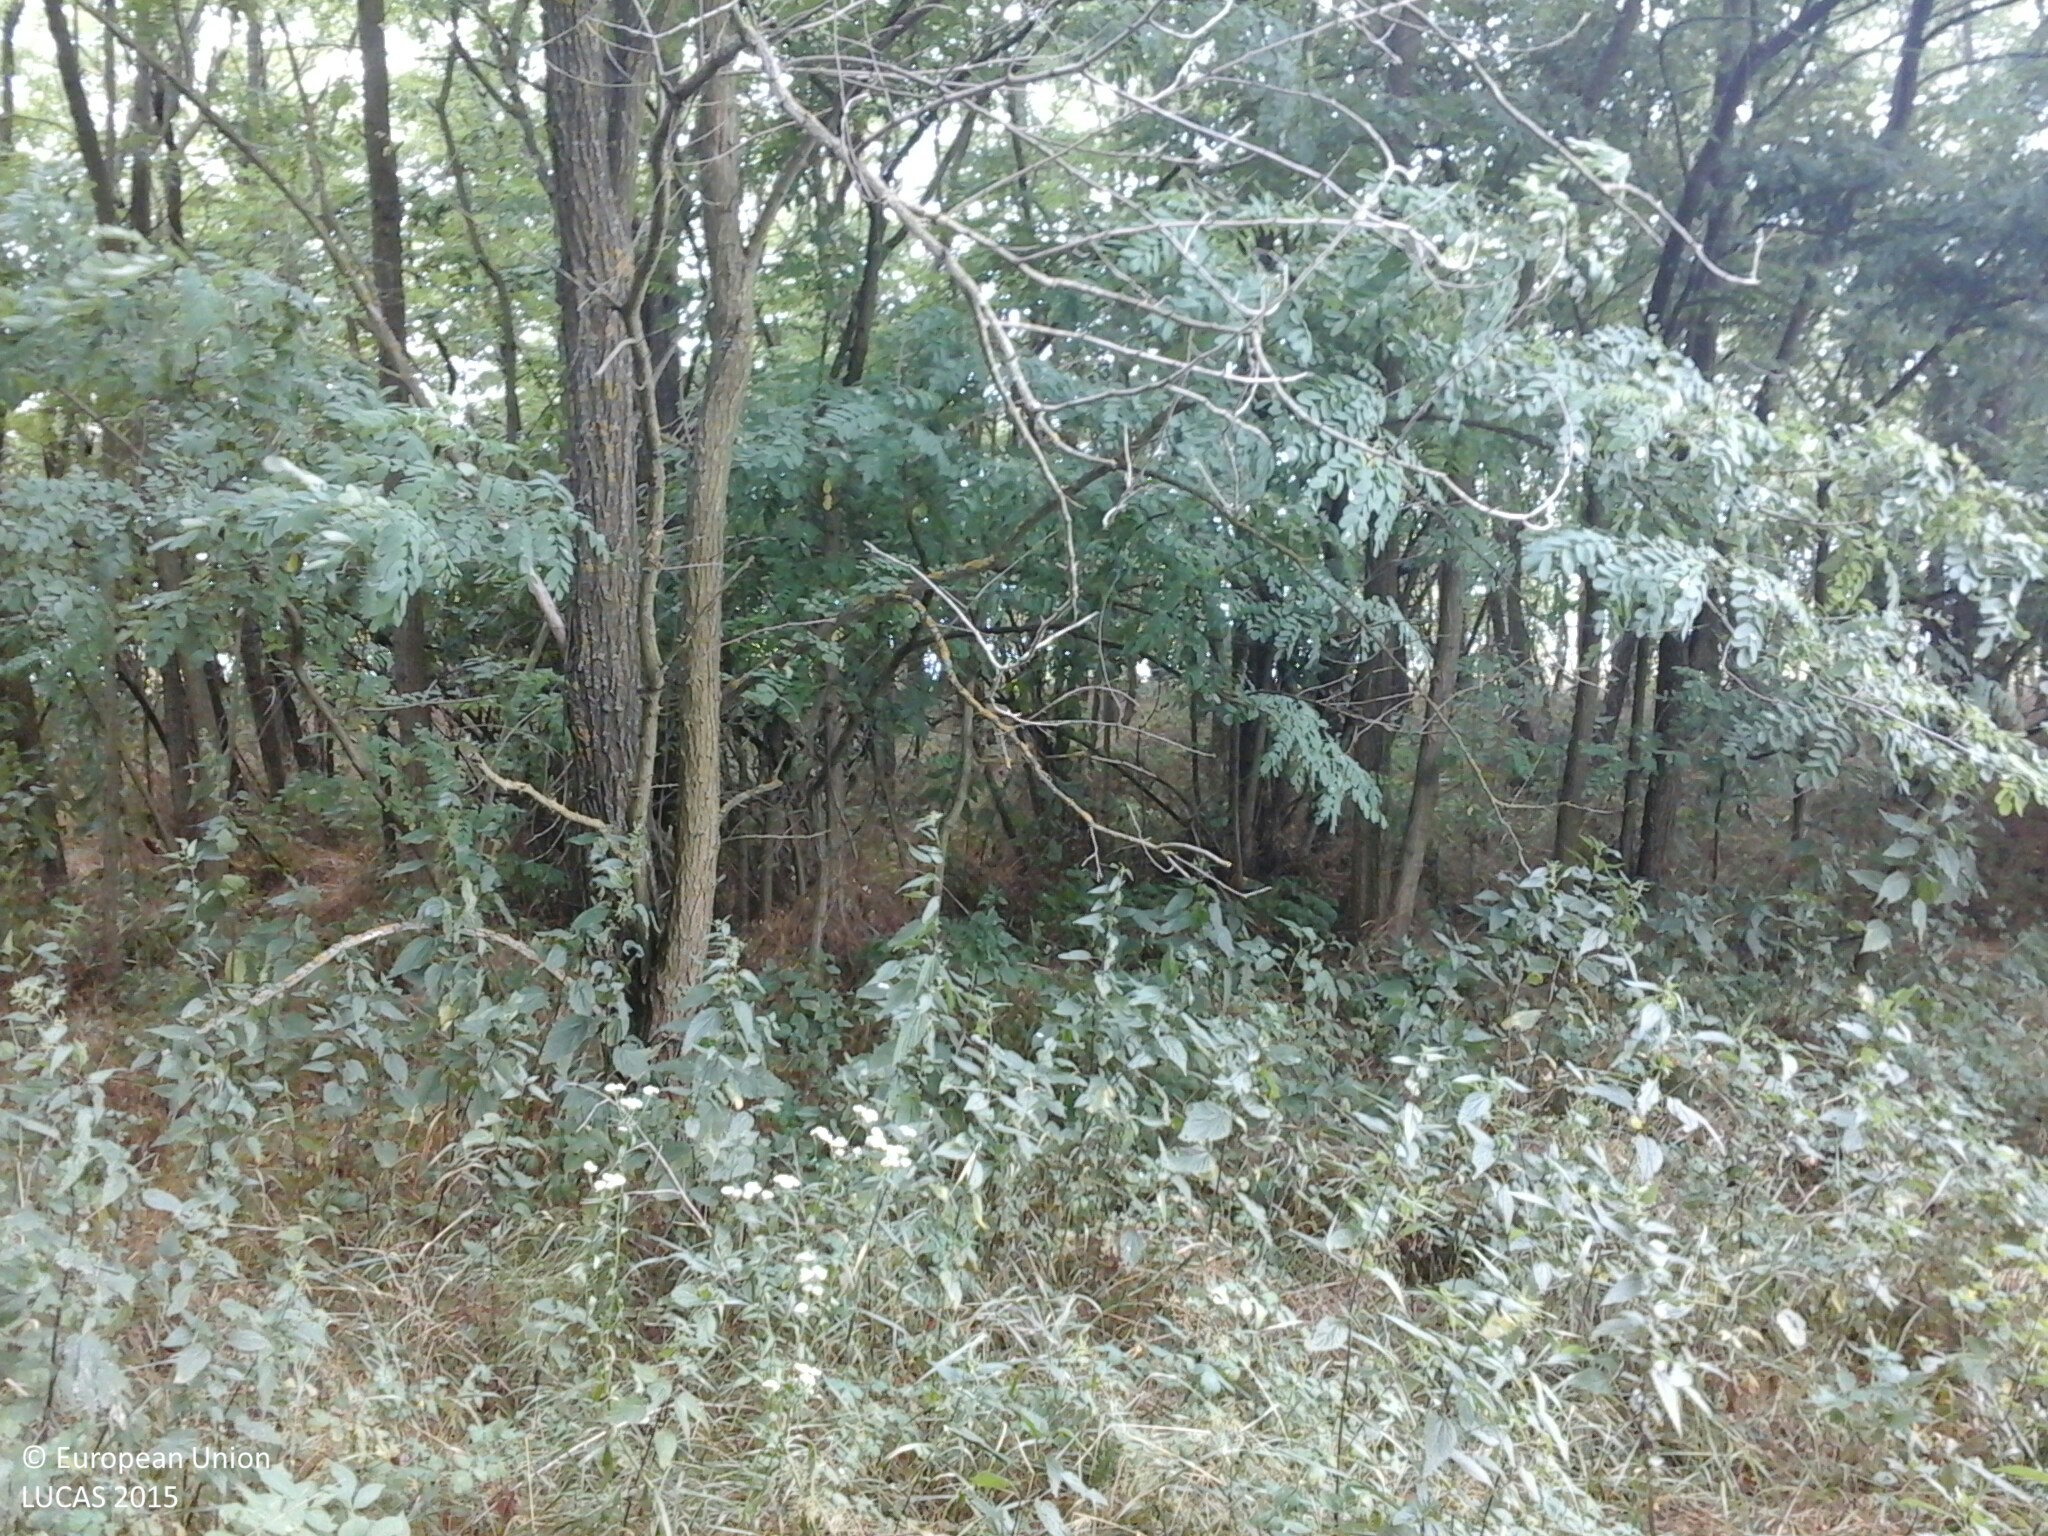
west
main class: Woodland
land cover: Broadleaved woodland
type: mesophytic deciduous forest
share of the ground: > 75 %
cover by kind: broadleaved forest trees 90 %, herbaceous plants 10 %
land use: Forestry
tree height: > 5 m
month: July
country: HU
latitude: 48.3628
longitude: 22.0261
